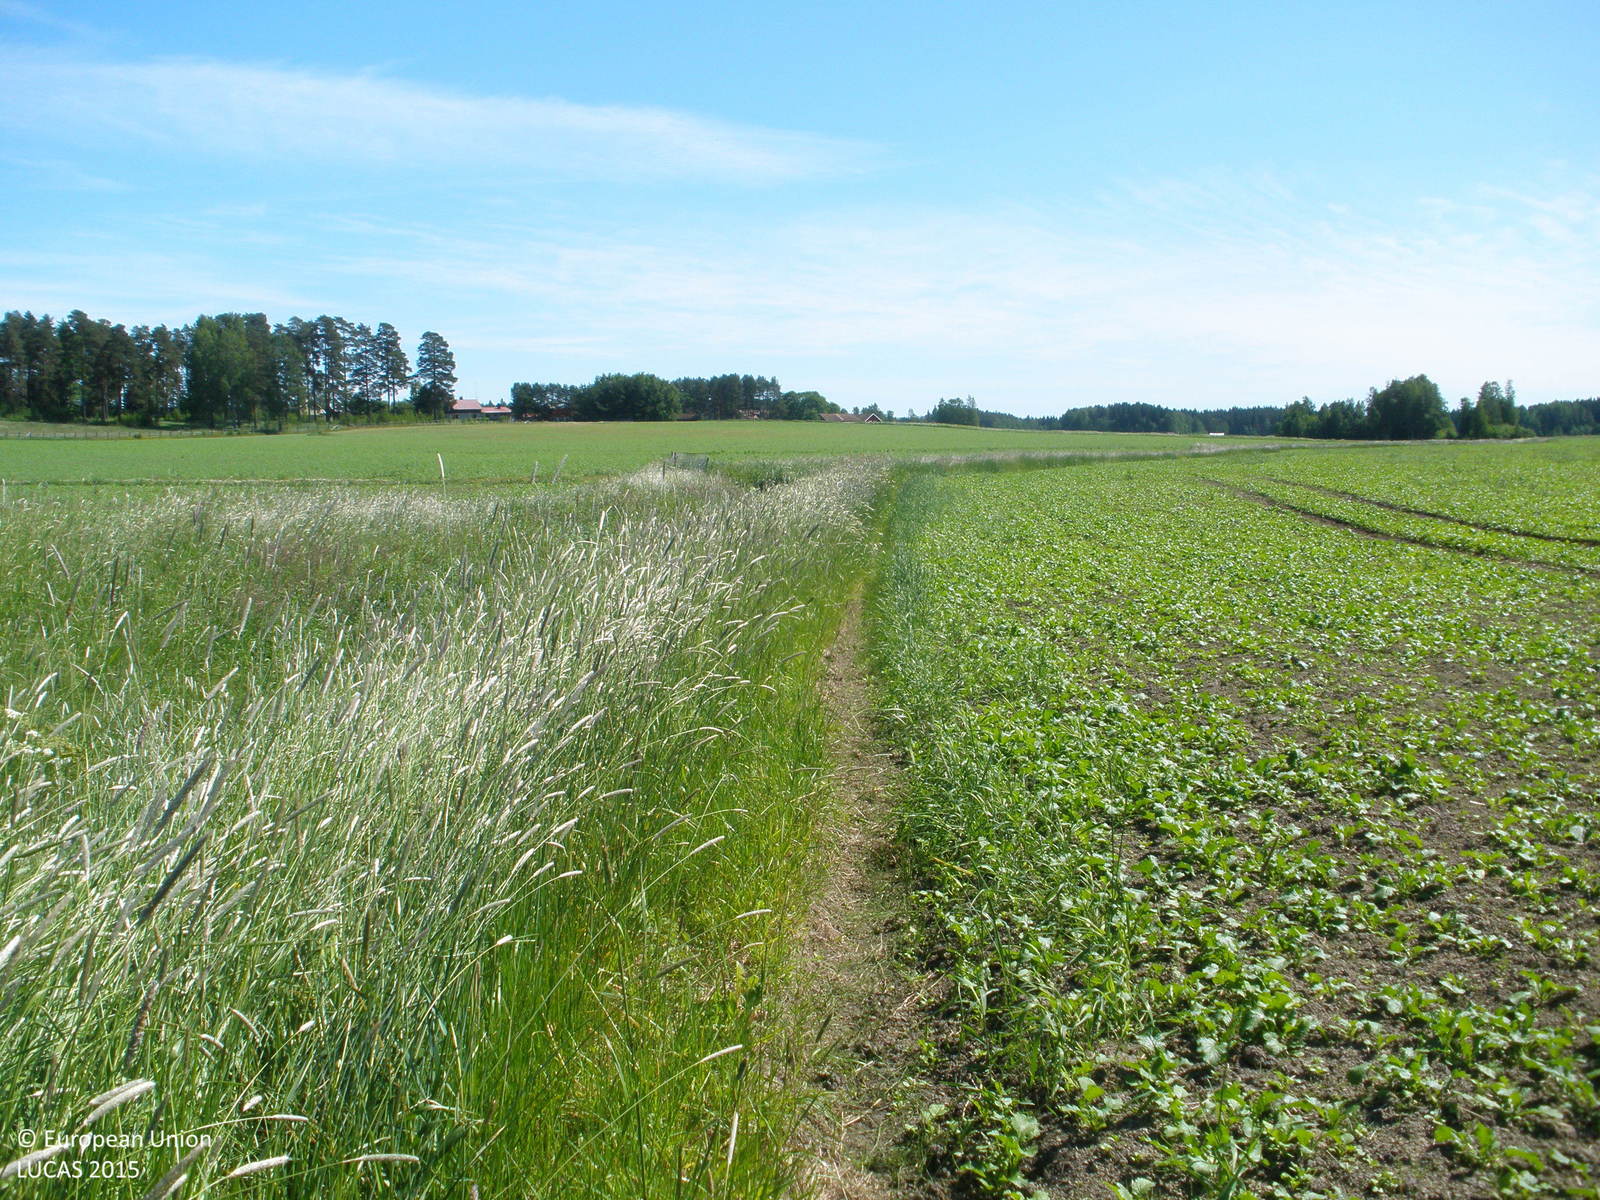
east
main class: Cropland
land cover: Other root crops
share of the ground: 10 - 25 %
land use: Agriculture (excluding fallow land and kitchen gardens)
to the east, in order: Other root crops; Grass margins; Ditches and canals; Grass margins; Other root crops
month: July
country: FI
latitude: 61.0470
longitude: 23.6973
